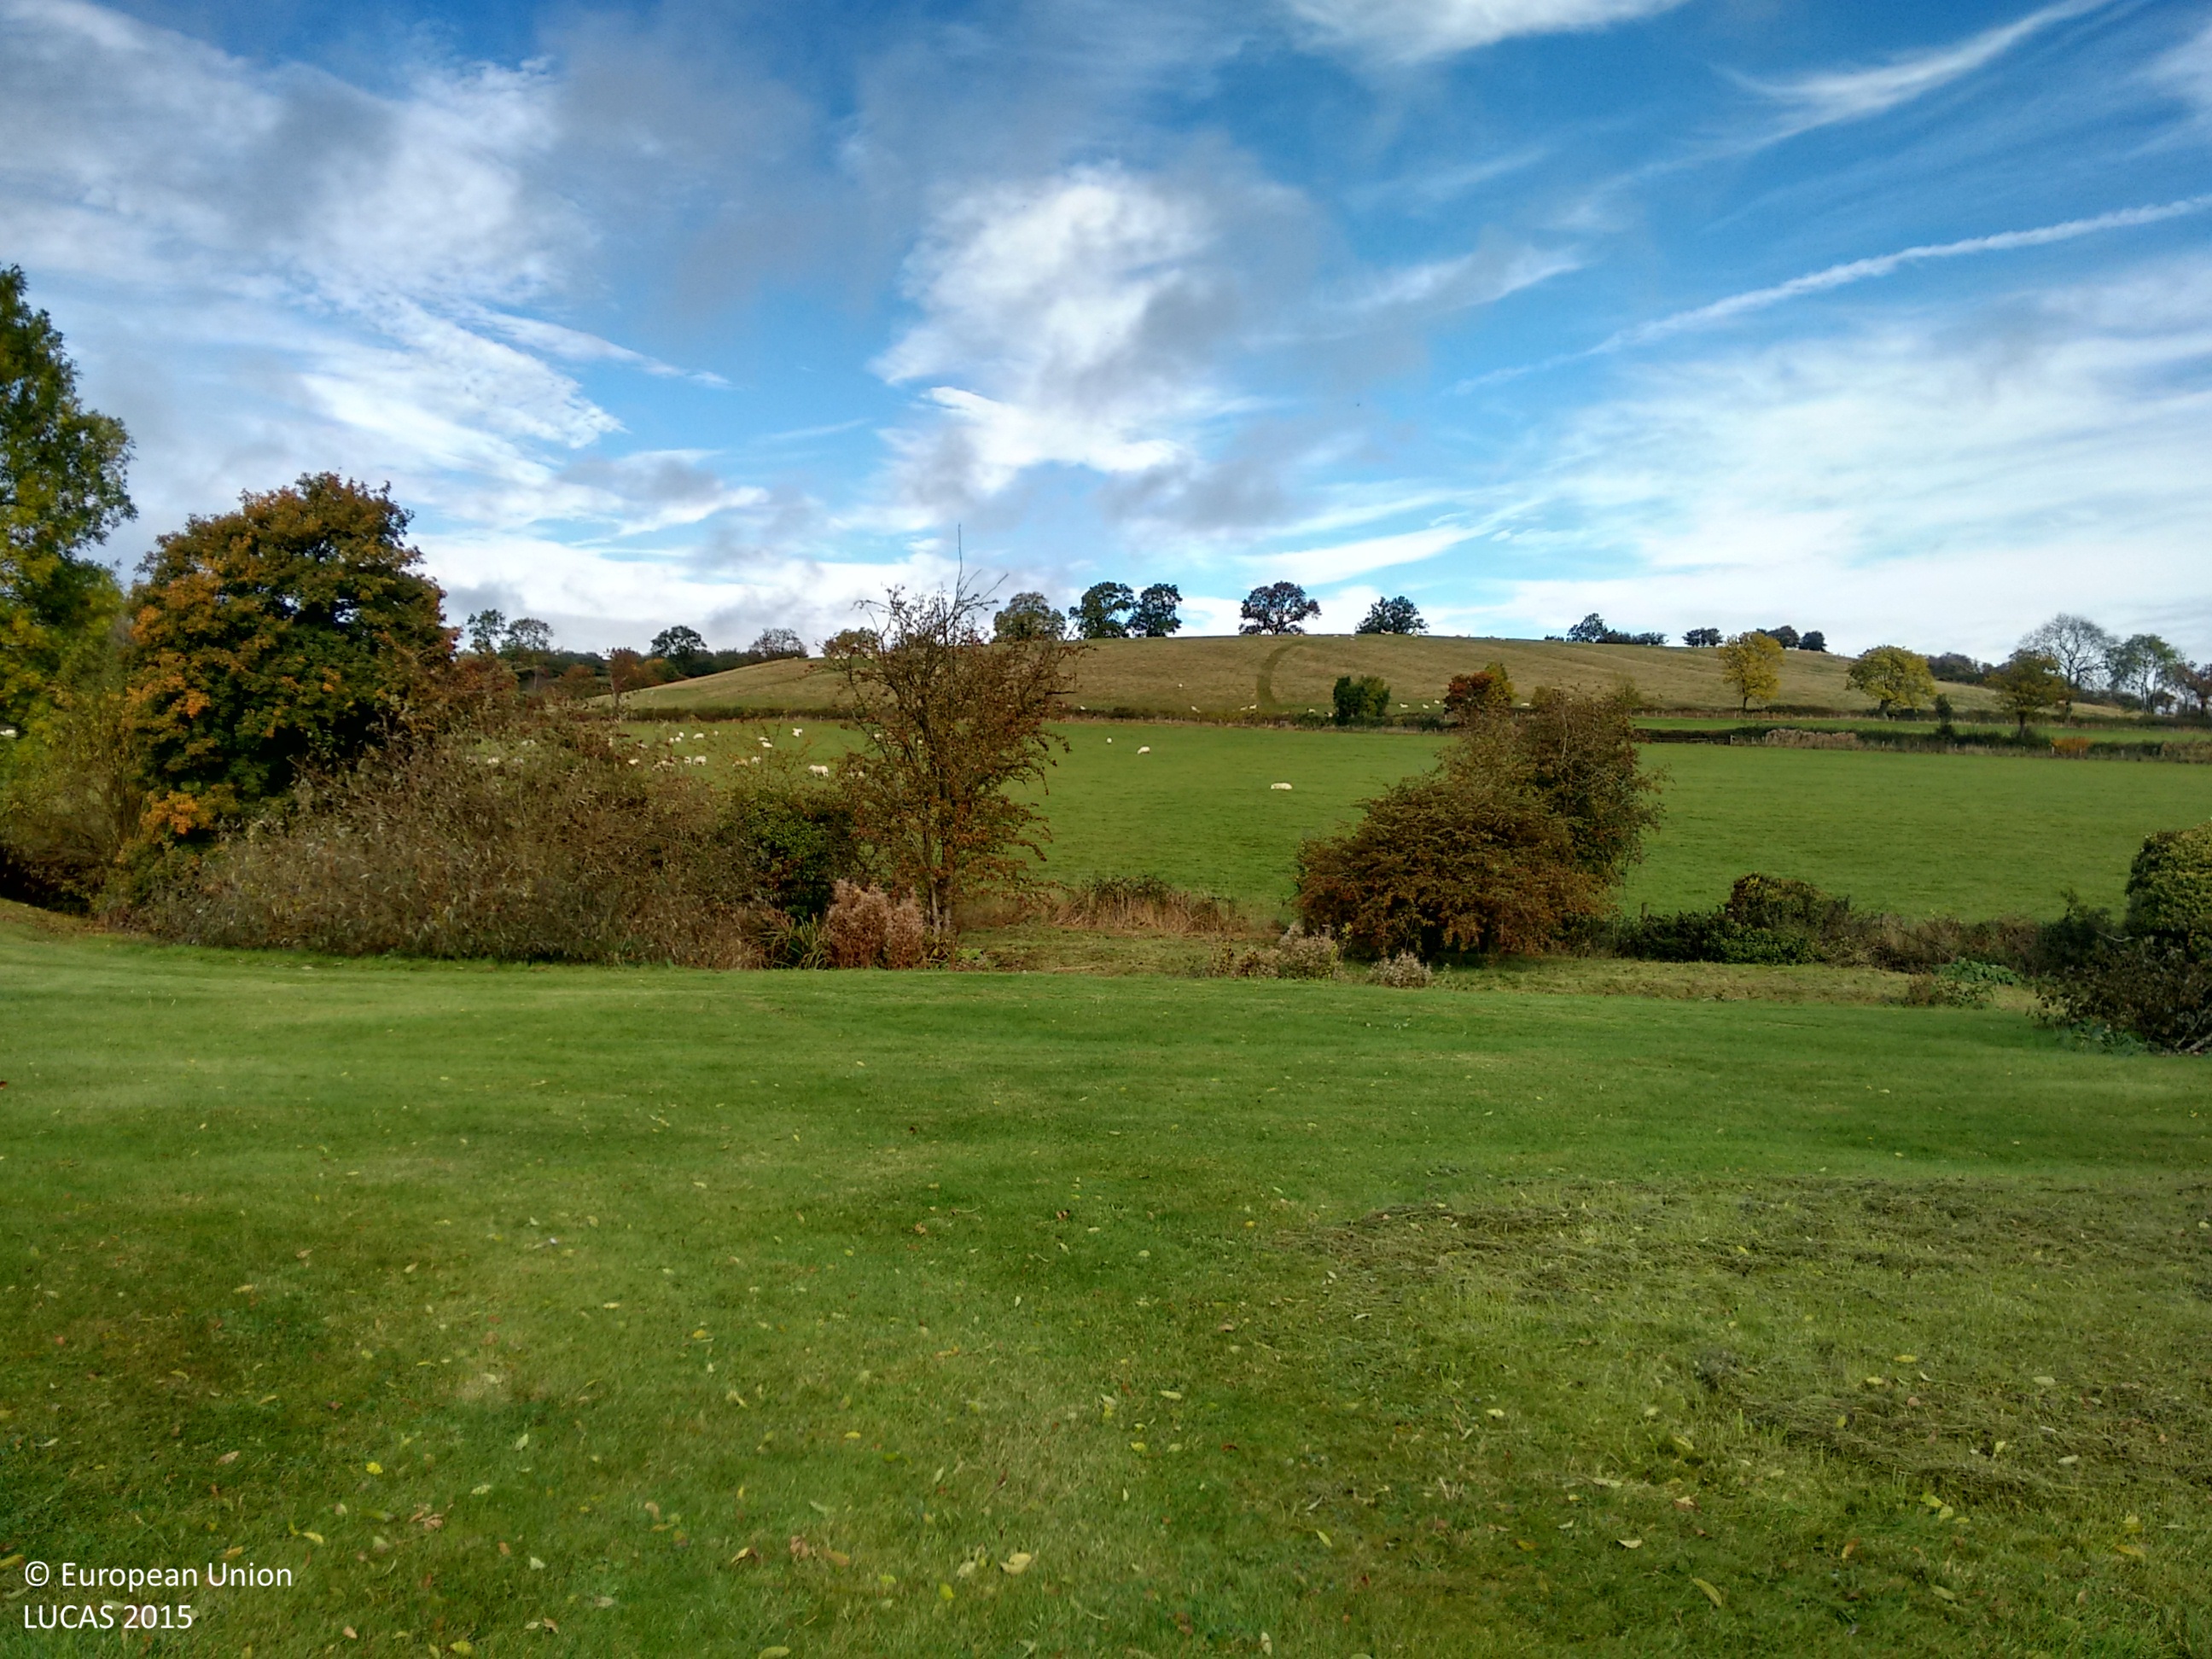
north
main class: Grassland
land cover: Grassland without tree/shrub cover
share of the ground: > 75 %
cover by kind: herbaceous plants 100 %
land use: Agriculture (excluding fallow land and kitchen gardens)
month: October
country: GB
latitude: 52.0505
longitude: -1.7053
